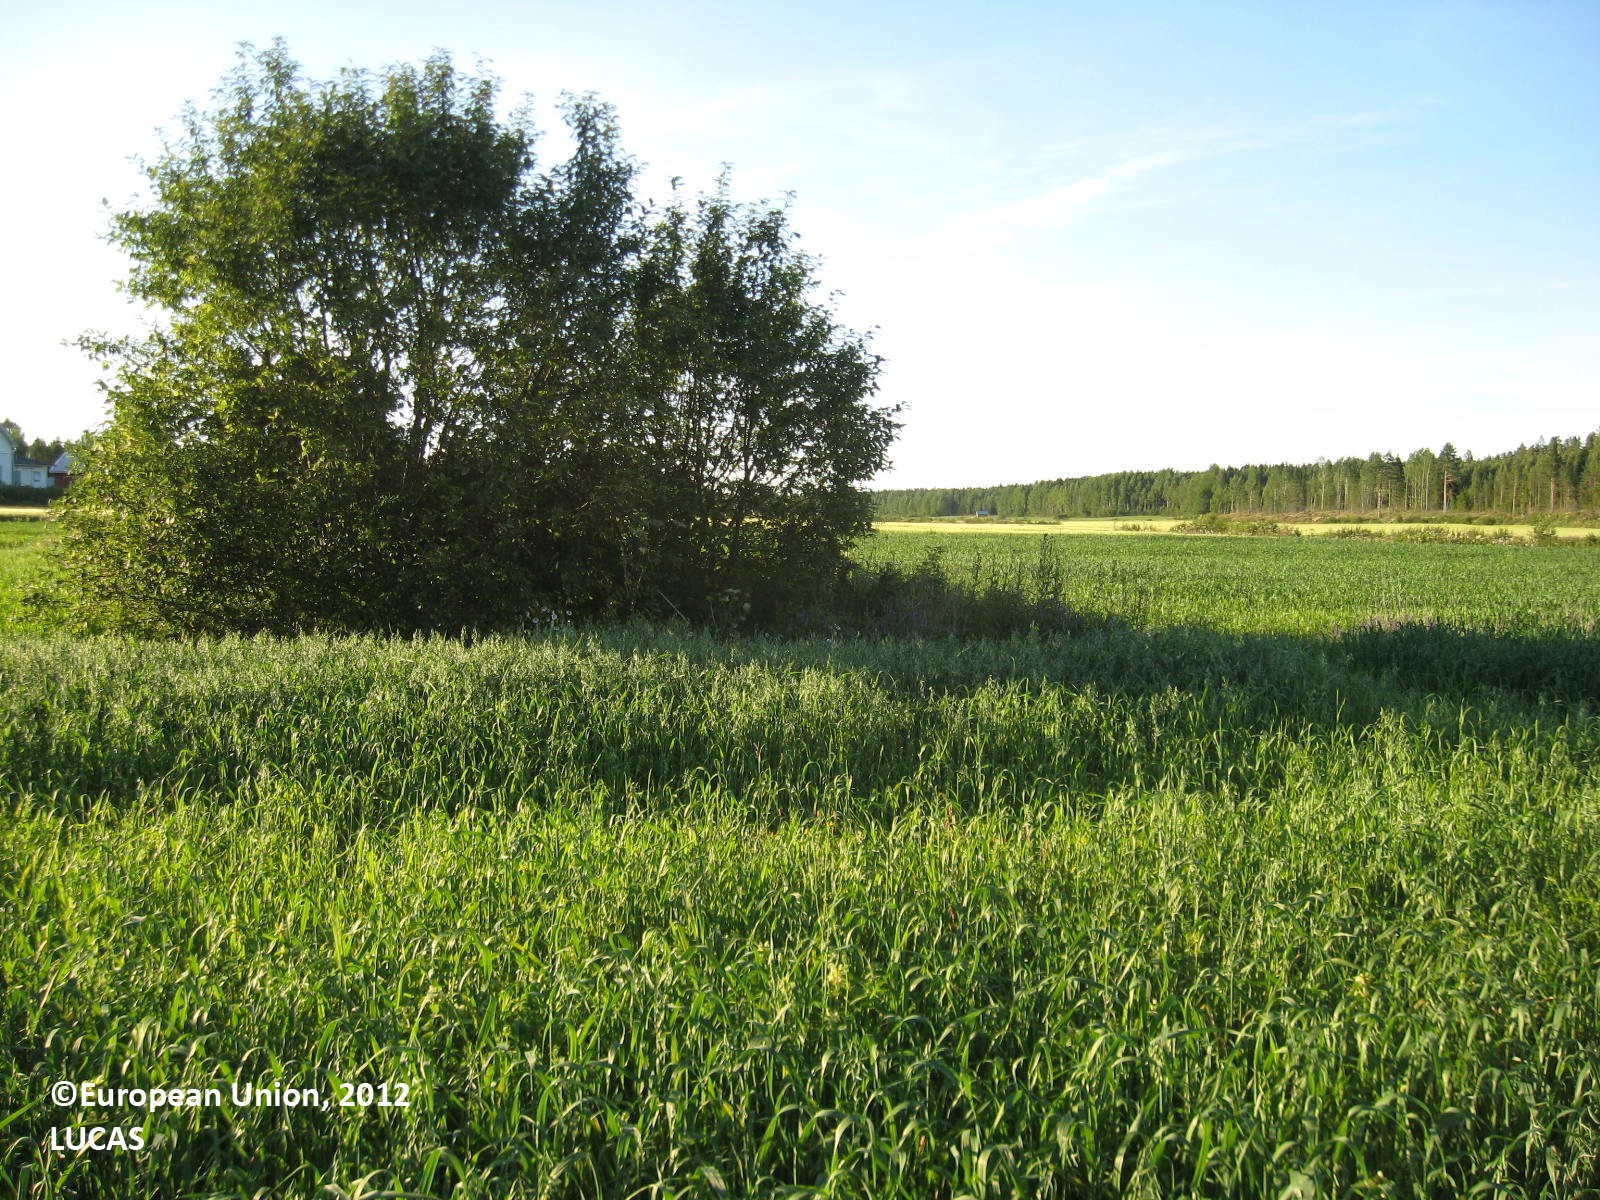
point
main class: Cropland
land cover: Oats
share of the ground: > 75 %
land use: Agriculture (excluding fallow land and kitchen gardens)
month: July
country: FI
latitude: 62.1460
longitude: 21.5774
